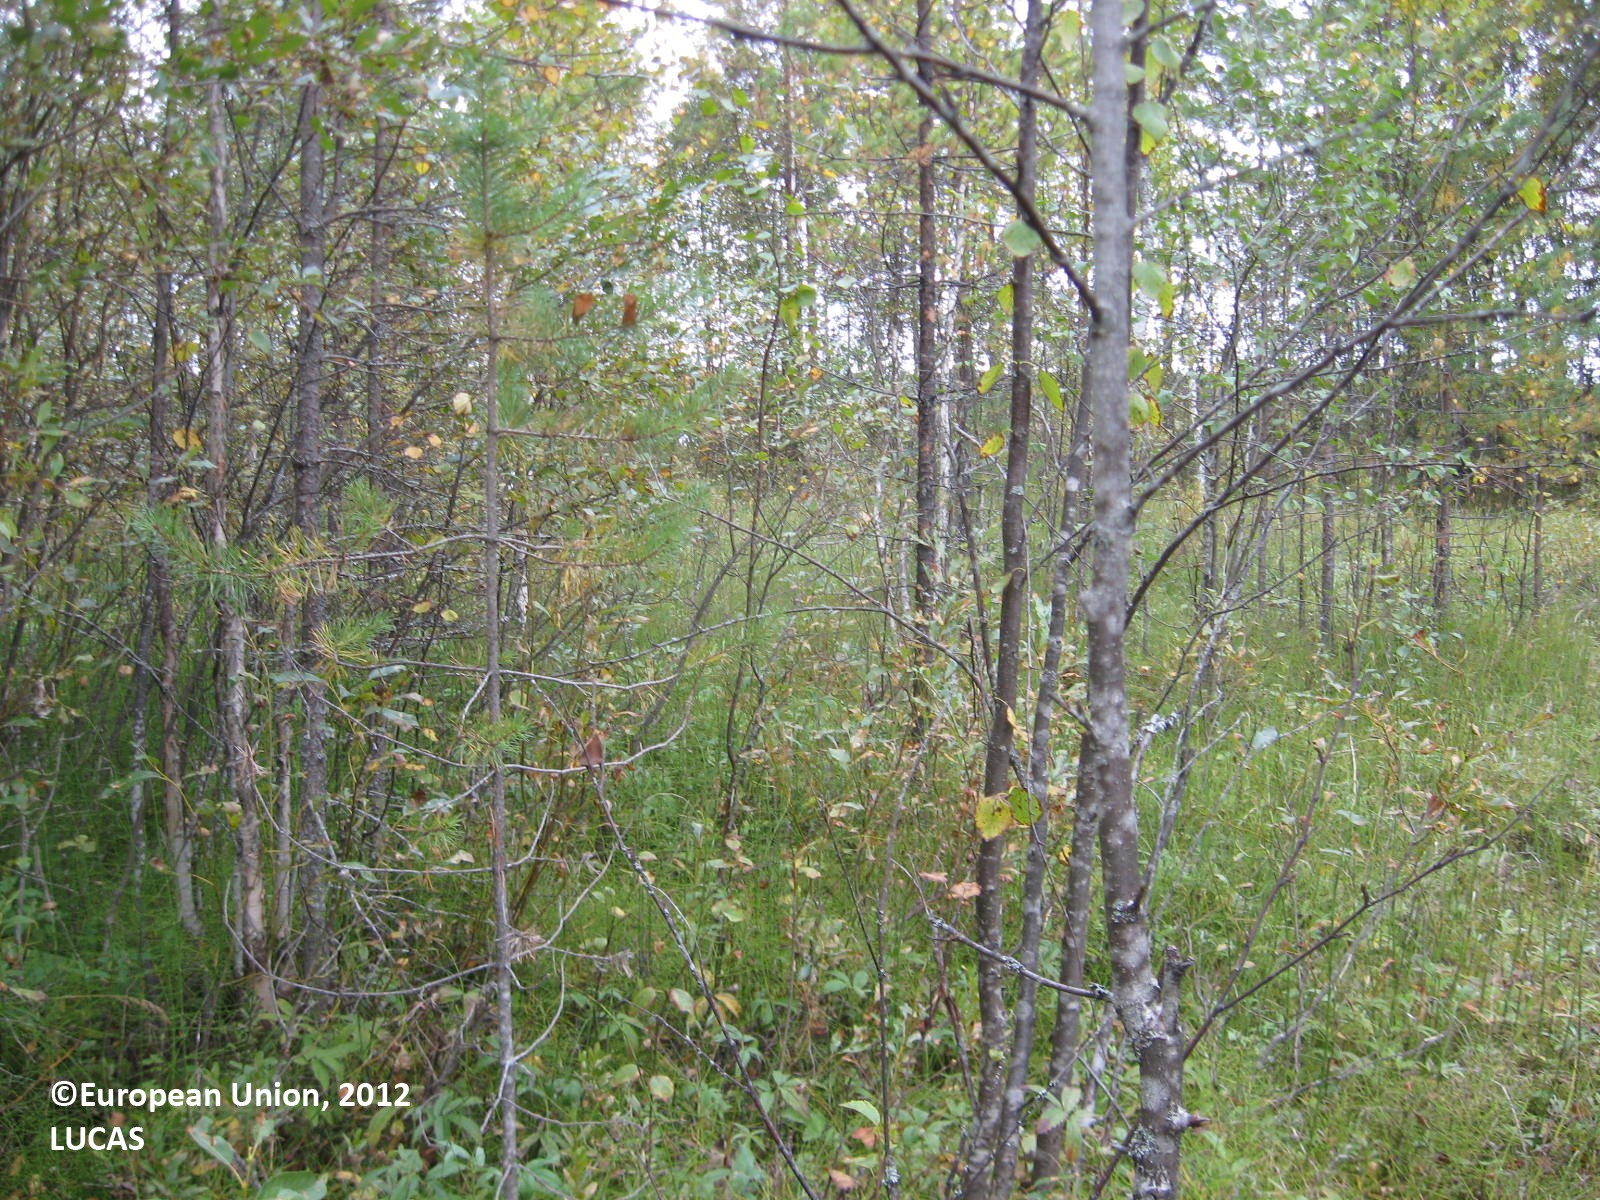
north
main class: Woodland
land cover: Other mixed woodland
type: boreal forest
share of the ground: > 75 %
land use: Forestry
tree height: > 5 m
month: September
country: FI
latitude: 64.0995
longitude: 28.1649
